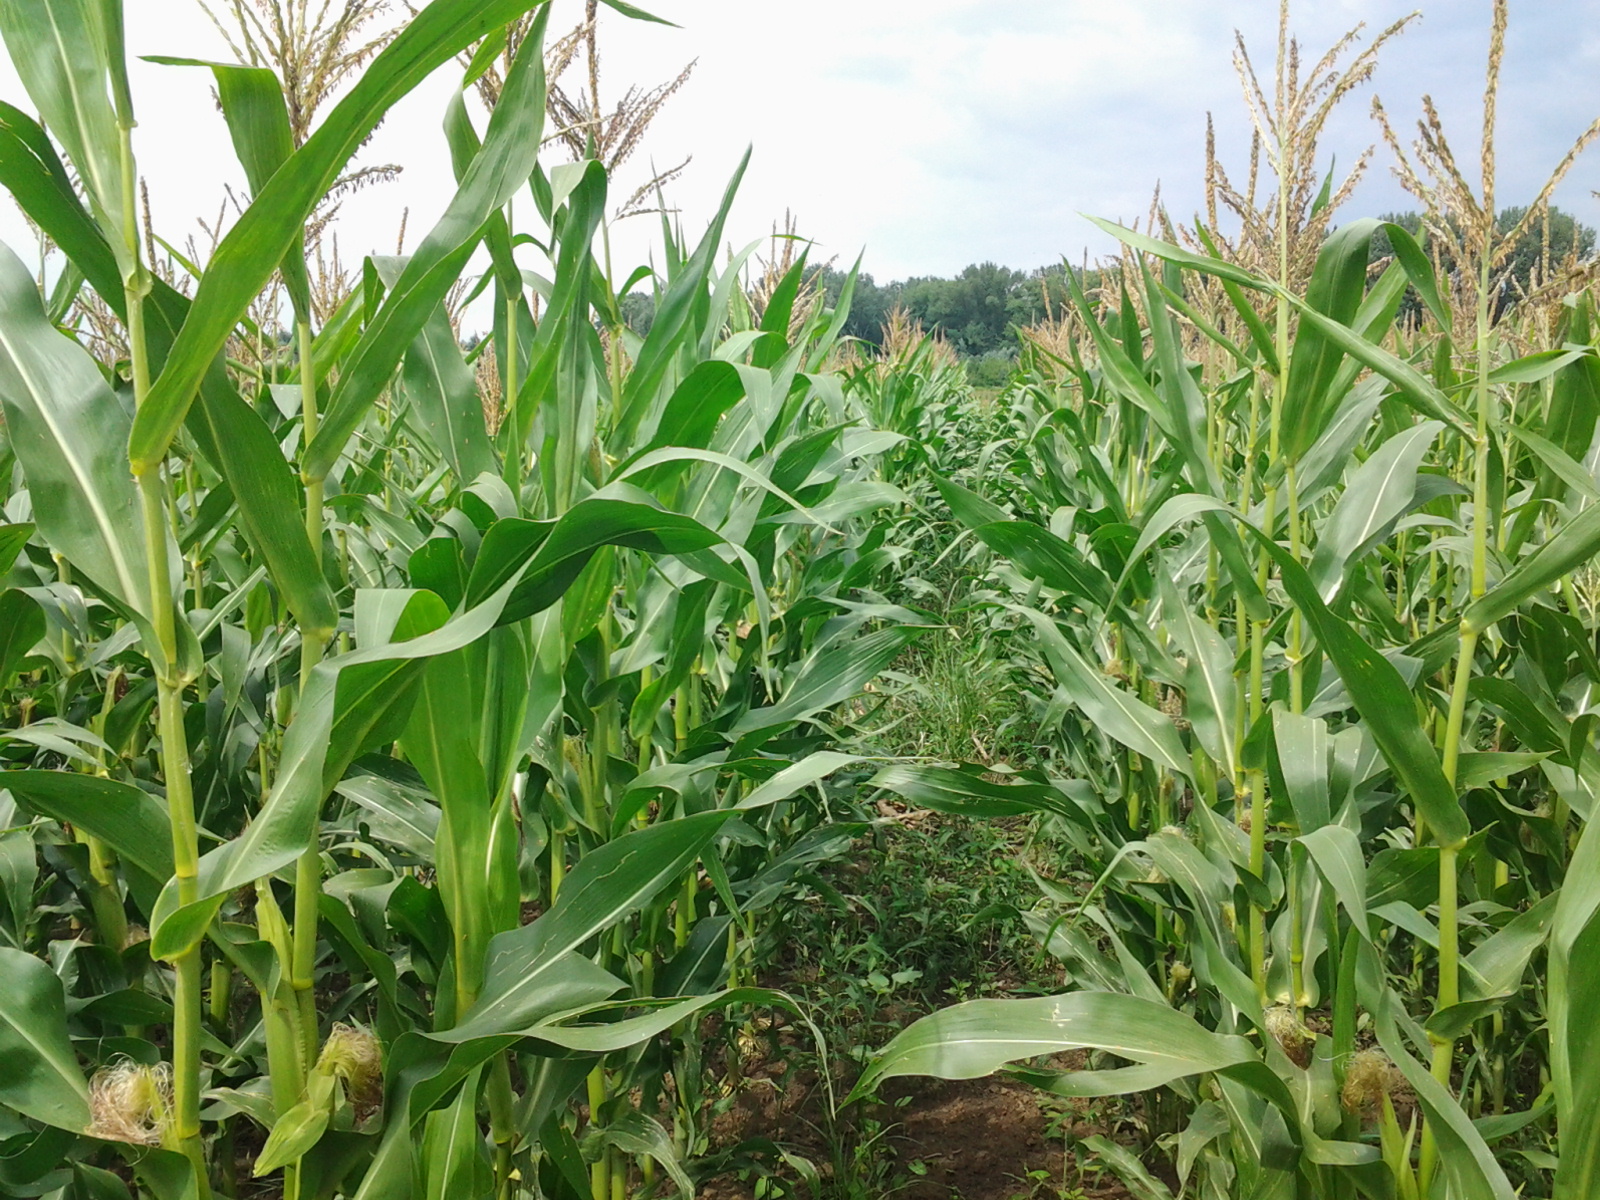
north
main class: Cropland
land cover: Maize
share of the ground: > 75 %
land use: Agriculture (excluding fallow land and kitchen gardens)
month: June
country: HU
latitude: 47.1180
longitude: 20.1615
